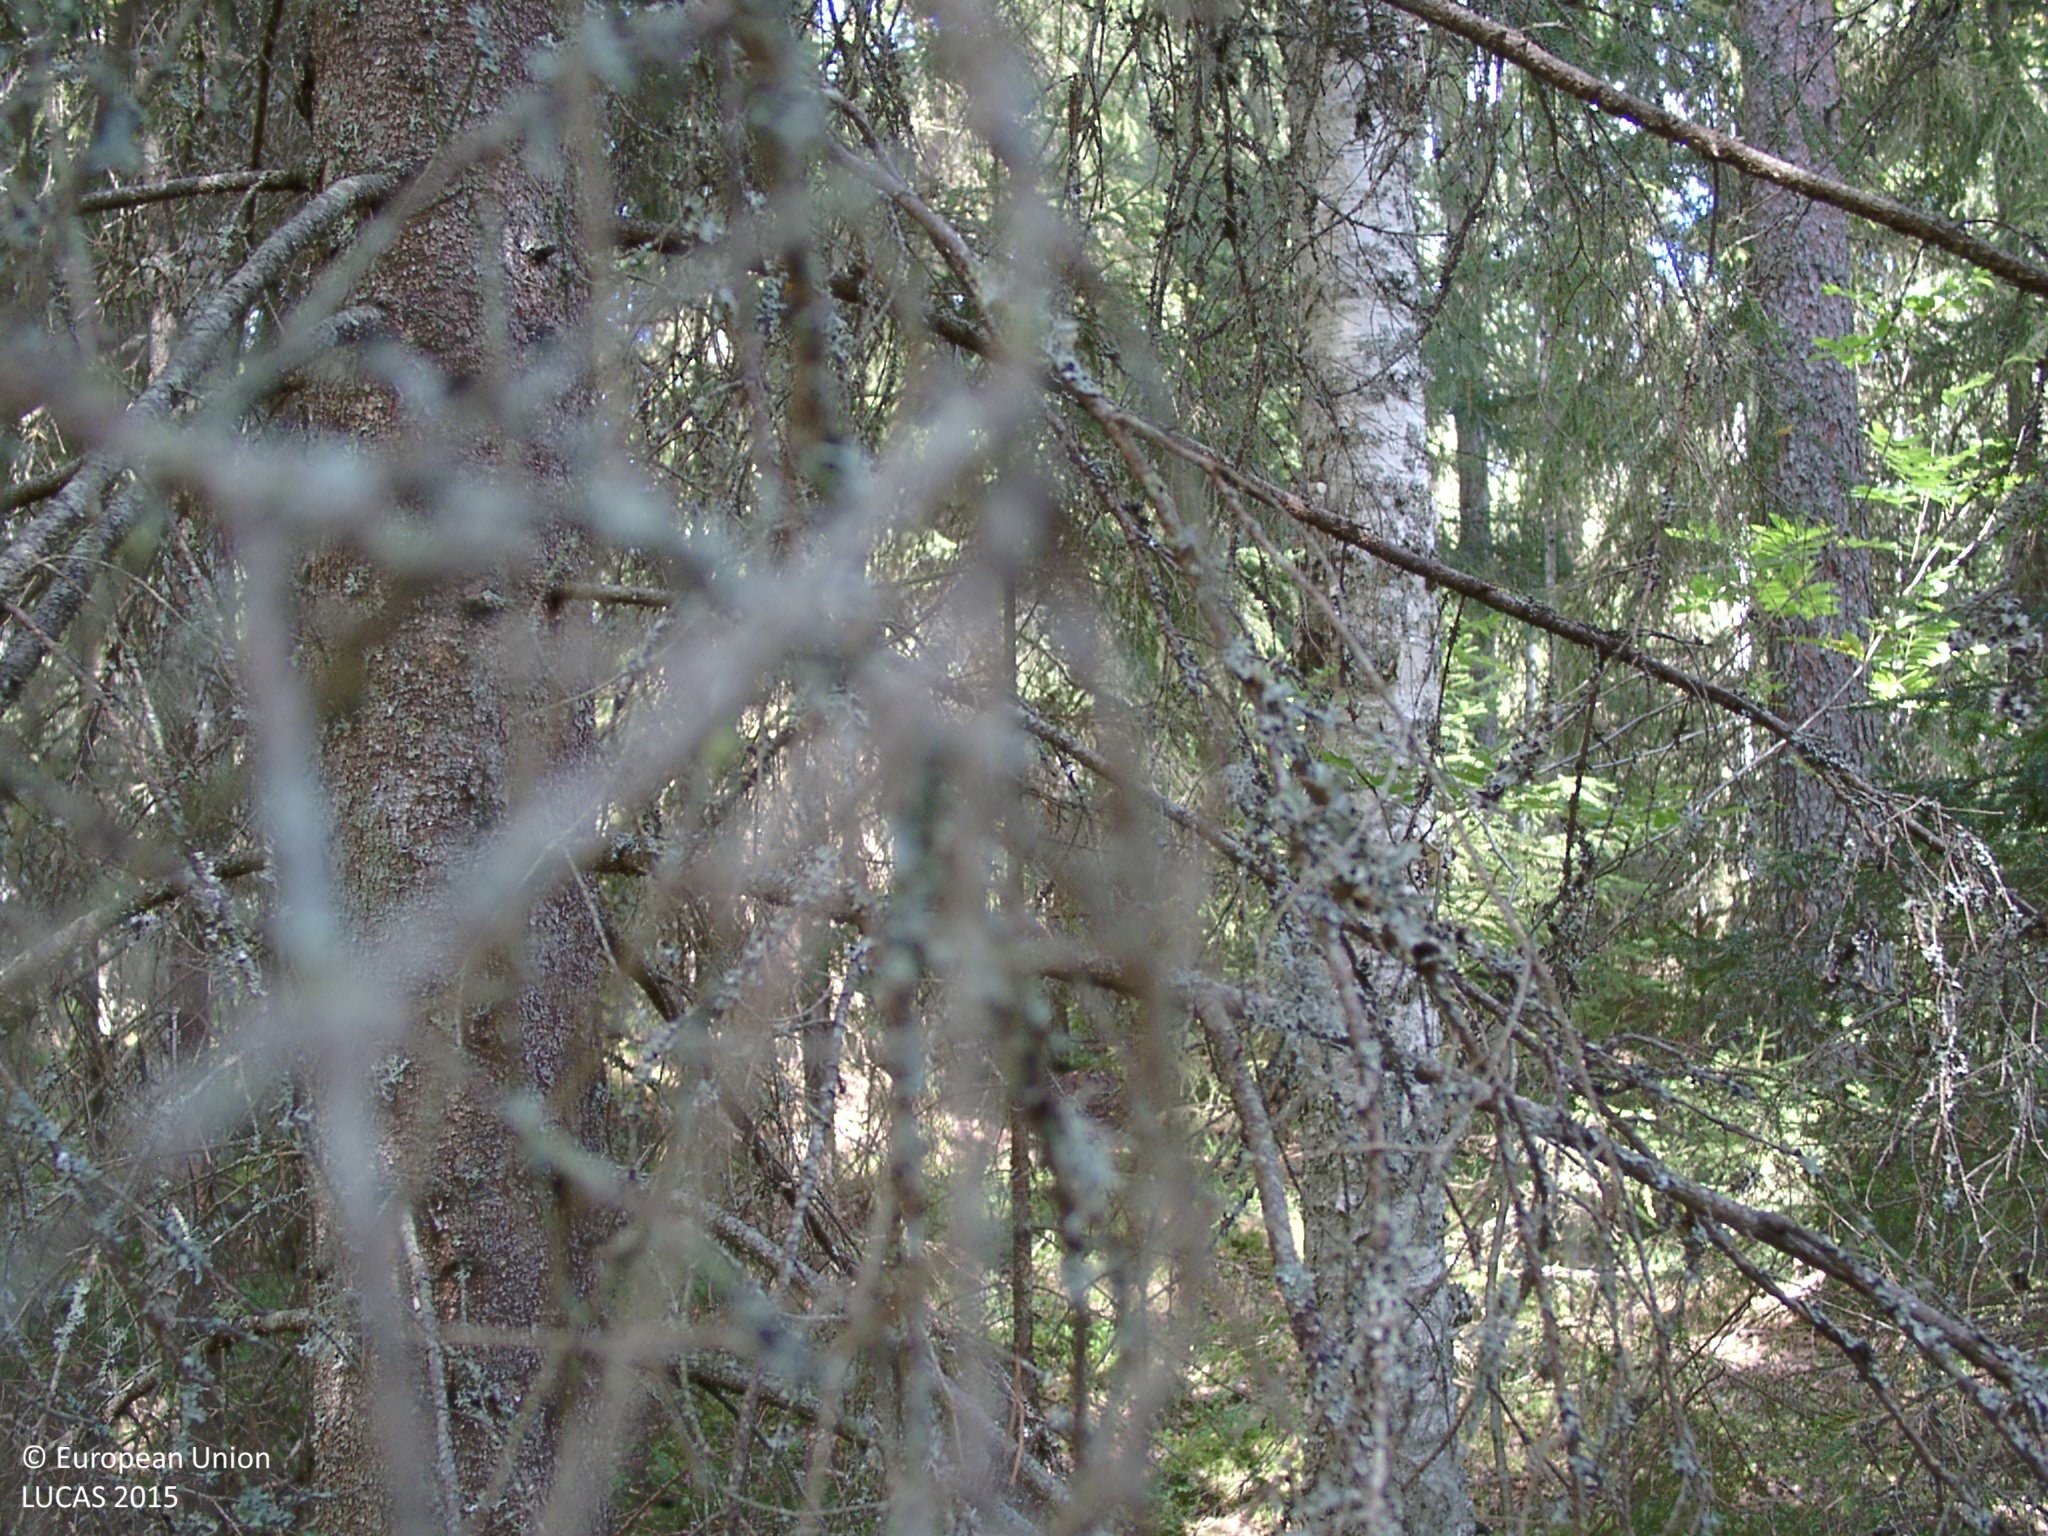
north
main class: Woodland
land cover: Other mixed woodland
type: boreal forest
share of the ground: > 75 %
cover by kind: coniferous forest trees 60 %, broadleaved forest trees 20 %, shrubs 10 %, lichens and mosses 10 %
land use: Forestry
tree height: > 5 m
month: August
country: FI
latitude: 61.8034
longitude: 24.9607
